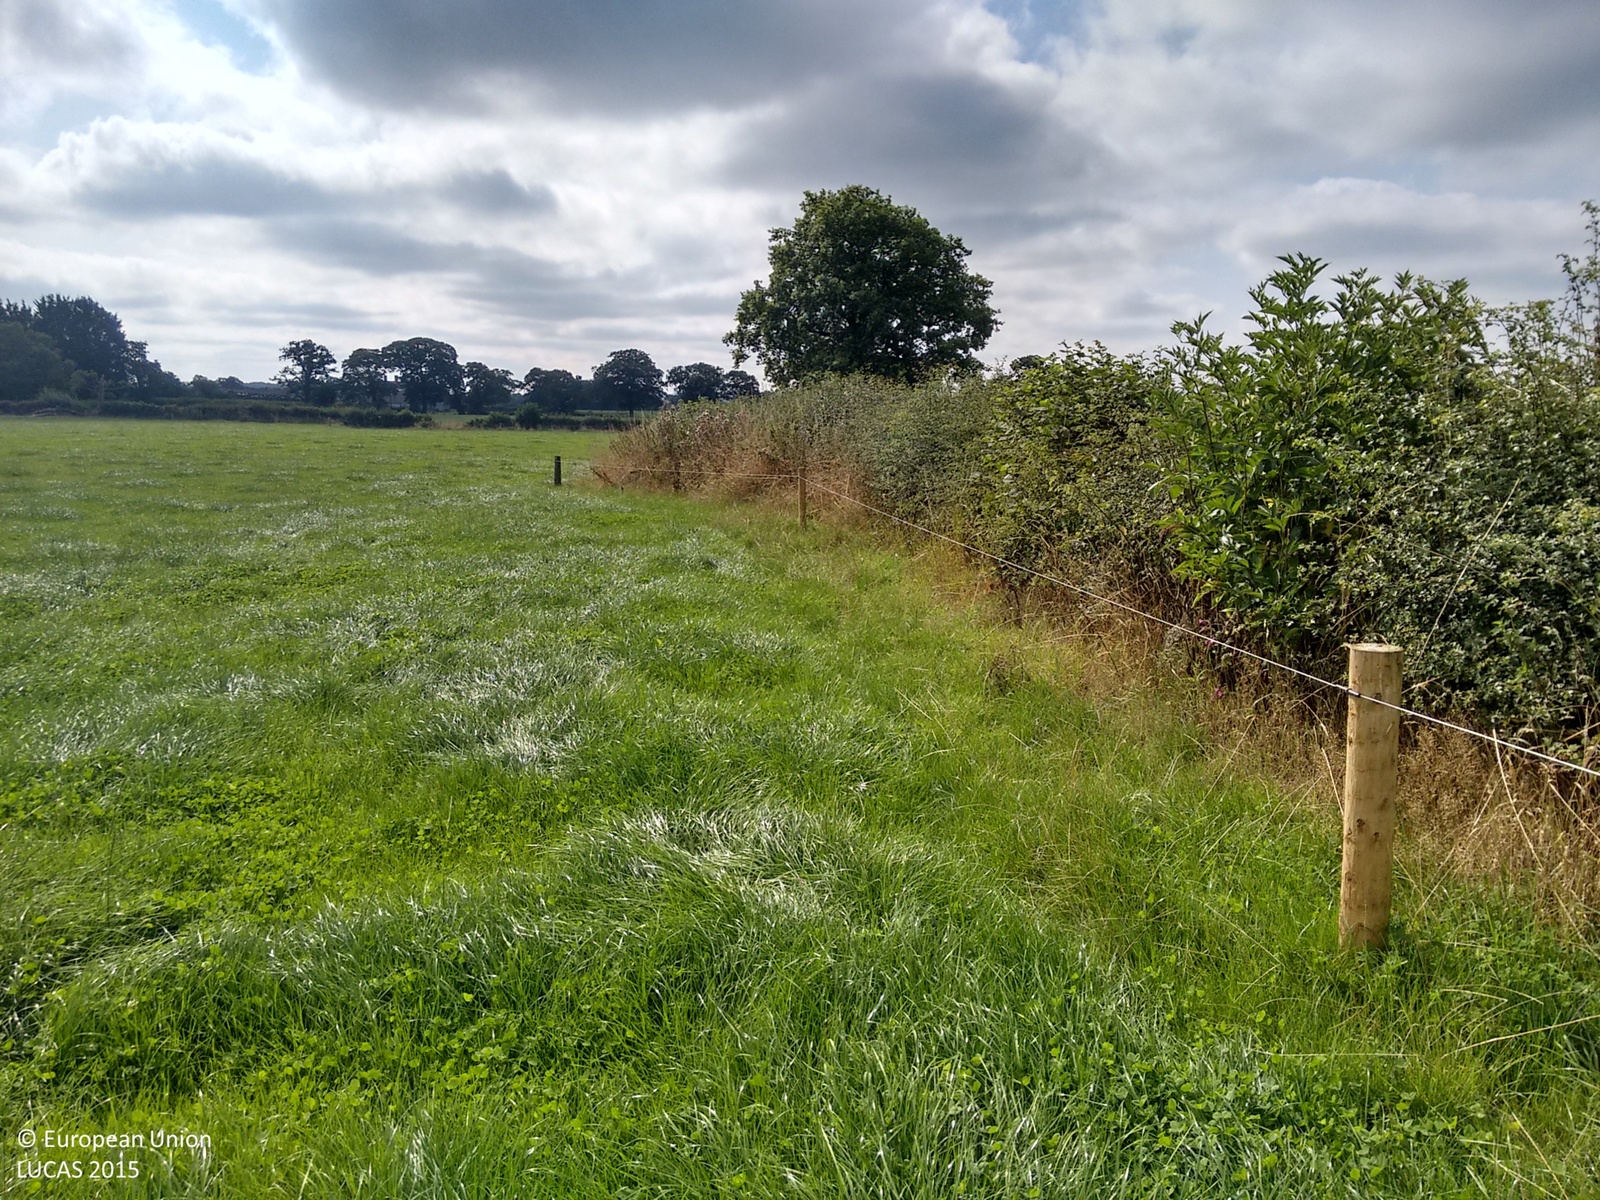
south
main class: Grassland
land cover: Grassland without tree/shrub cover
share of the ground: > 75 %
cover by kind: herbaceous plants 100 %
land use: Agriculture (excluding fallow land and kitchen gardens)
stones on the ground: < 10 %
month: September
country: GB
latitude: 52.9395
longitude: -2.6116
